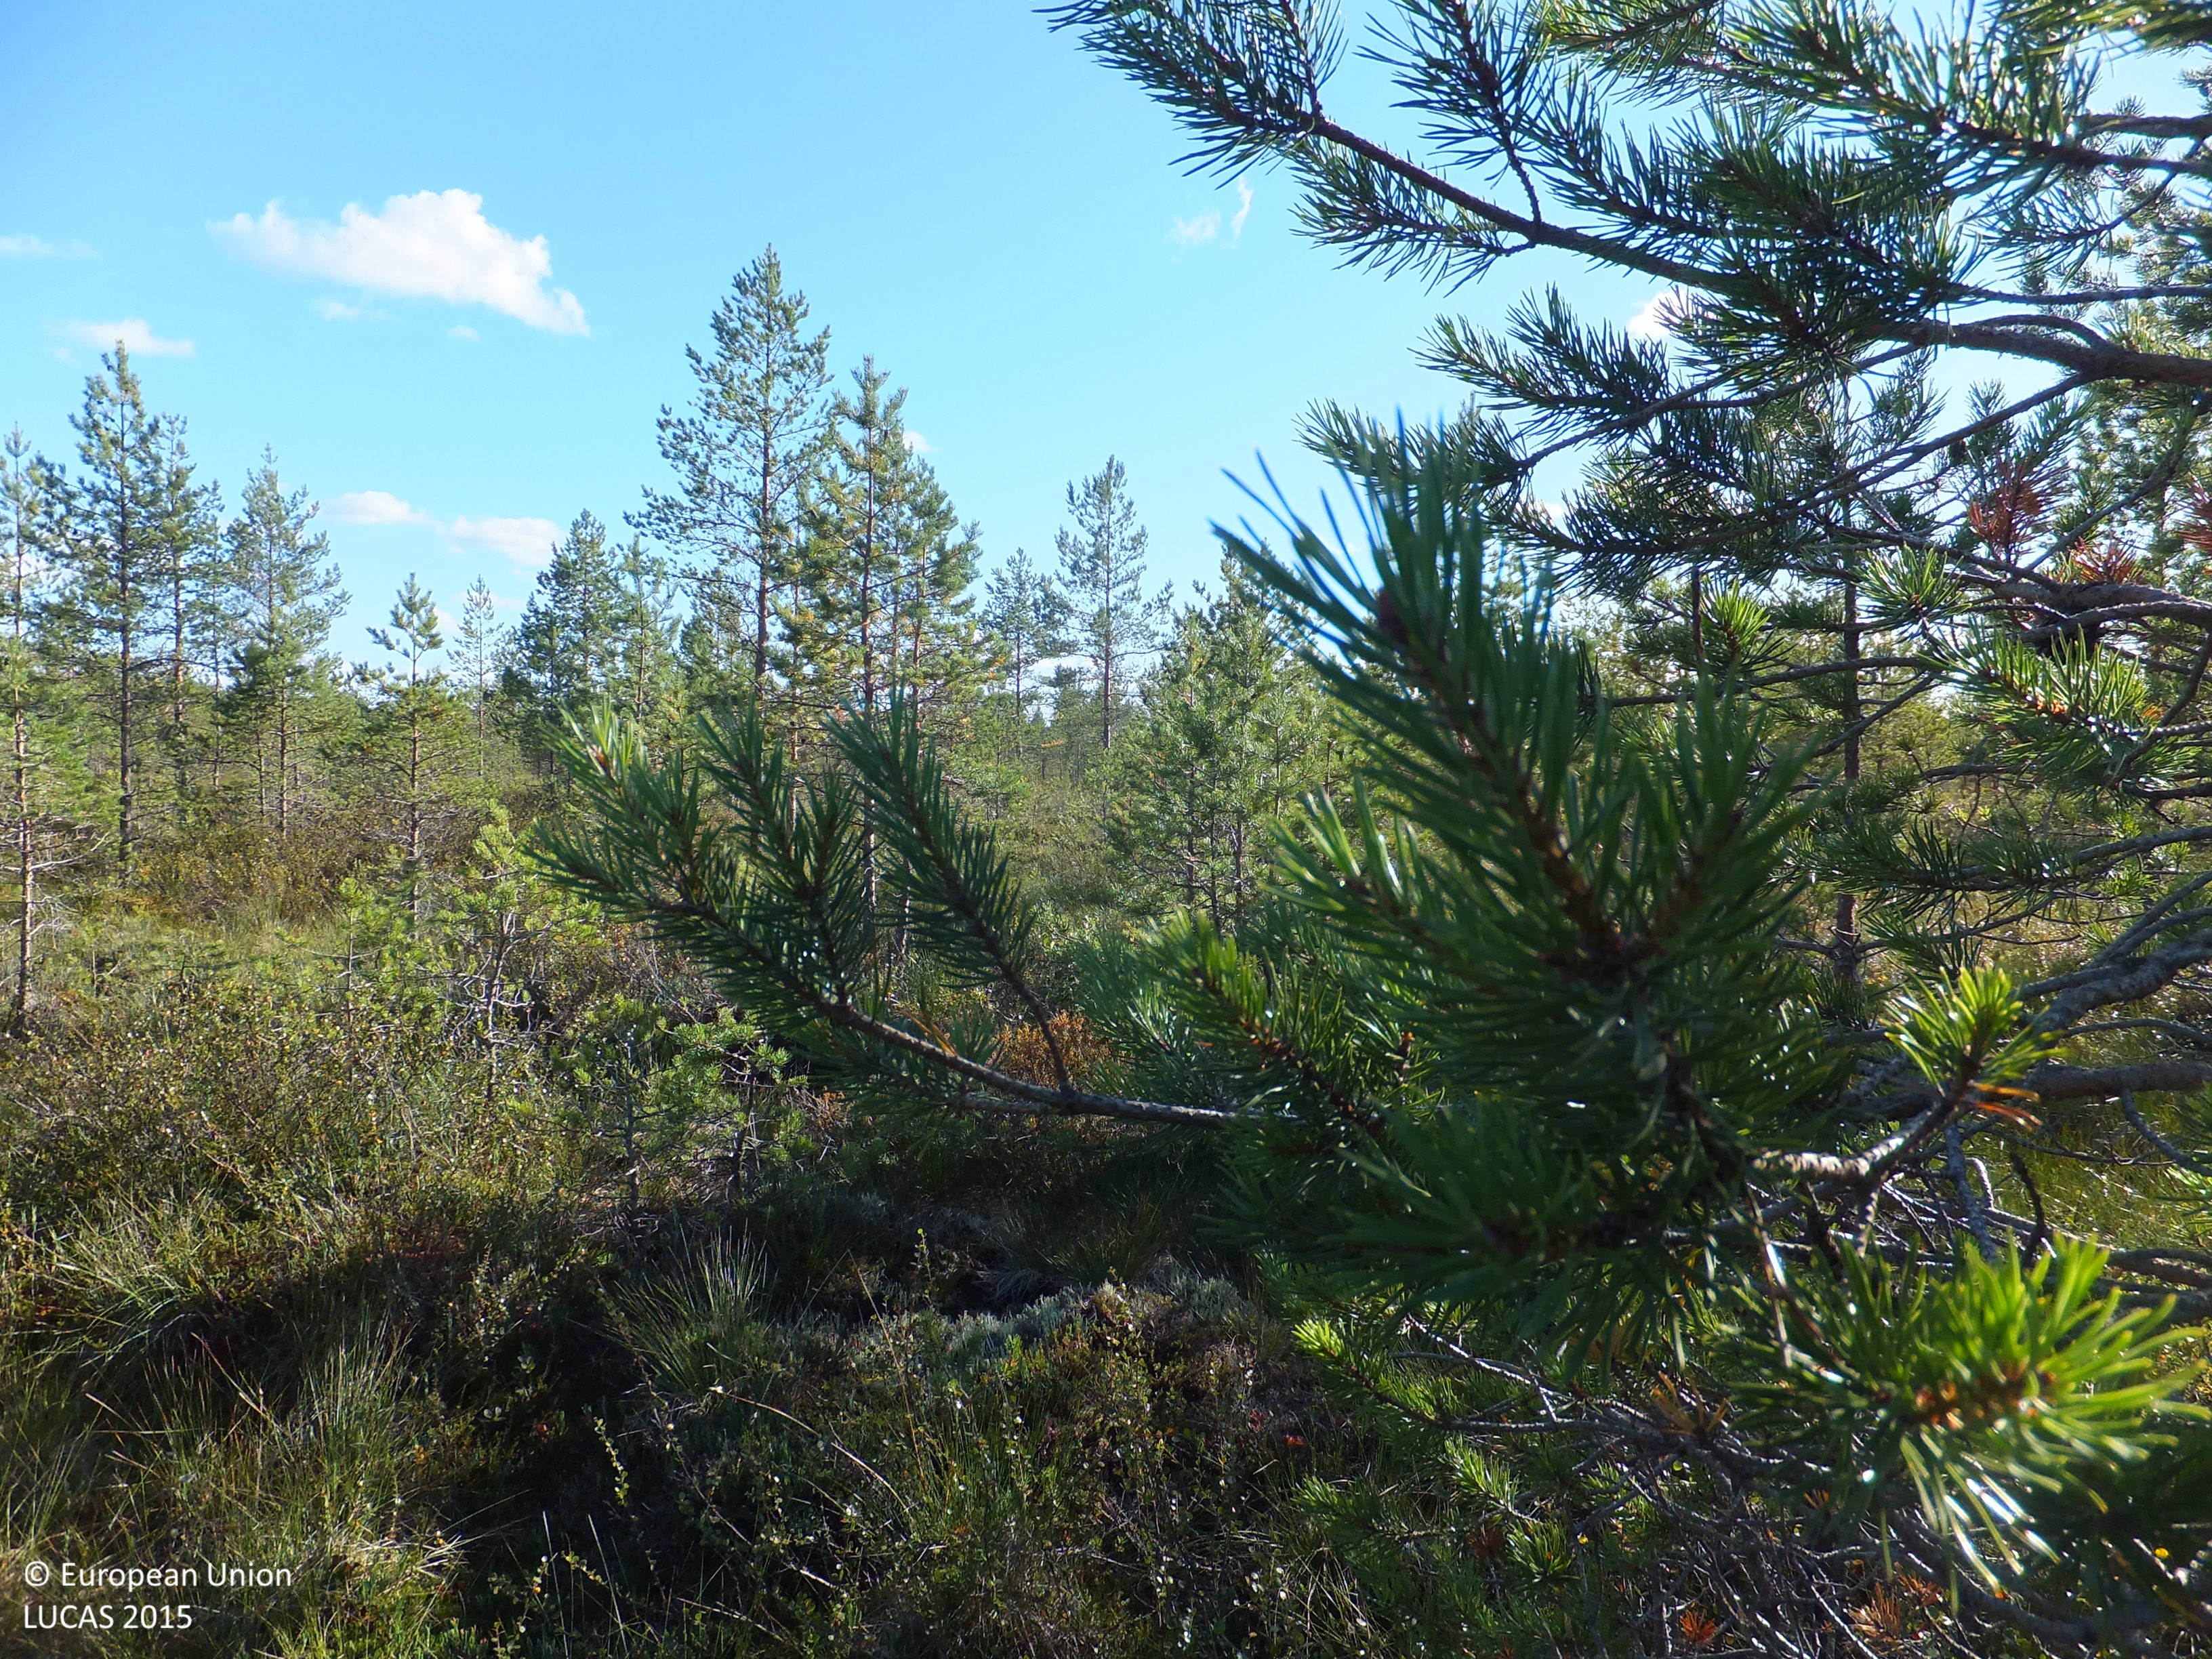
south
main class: Woodland
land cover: Pine dominated coniferous woodland
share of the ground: 25 - 50 %
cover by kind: coniferous forest trees 35 %, lichens and mosses 30 %, shrubs 20 %, herbaceous plants 10 %, broadleaved forest trees 5 %
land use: Forestry
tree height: < 5 m
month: August
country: FI
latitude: 63.1762
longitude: 23.0687
